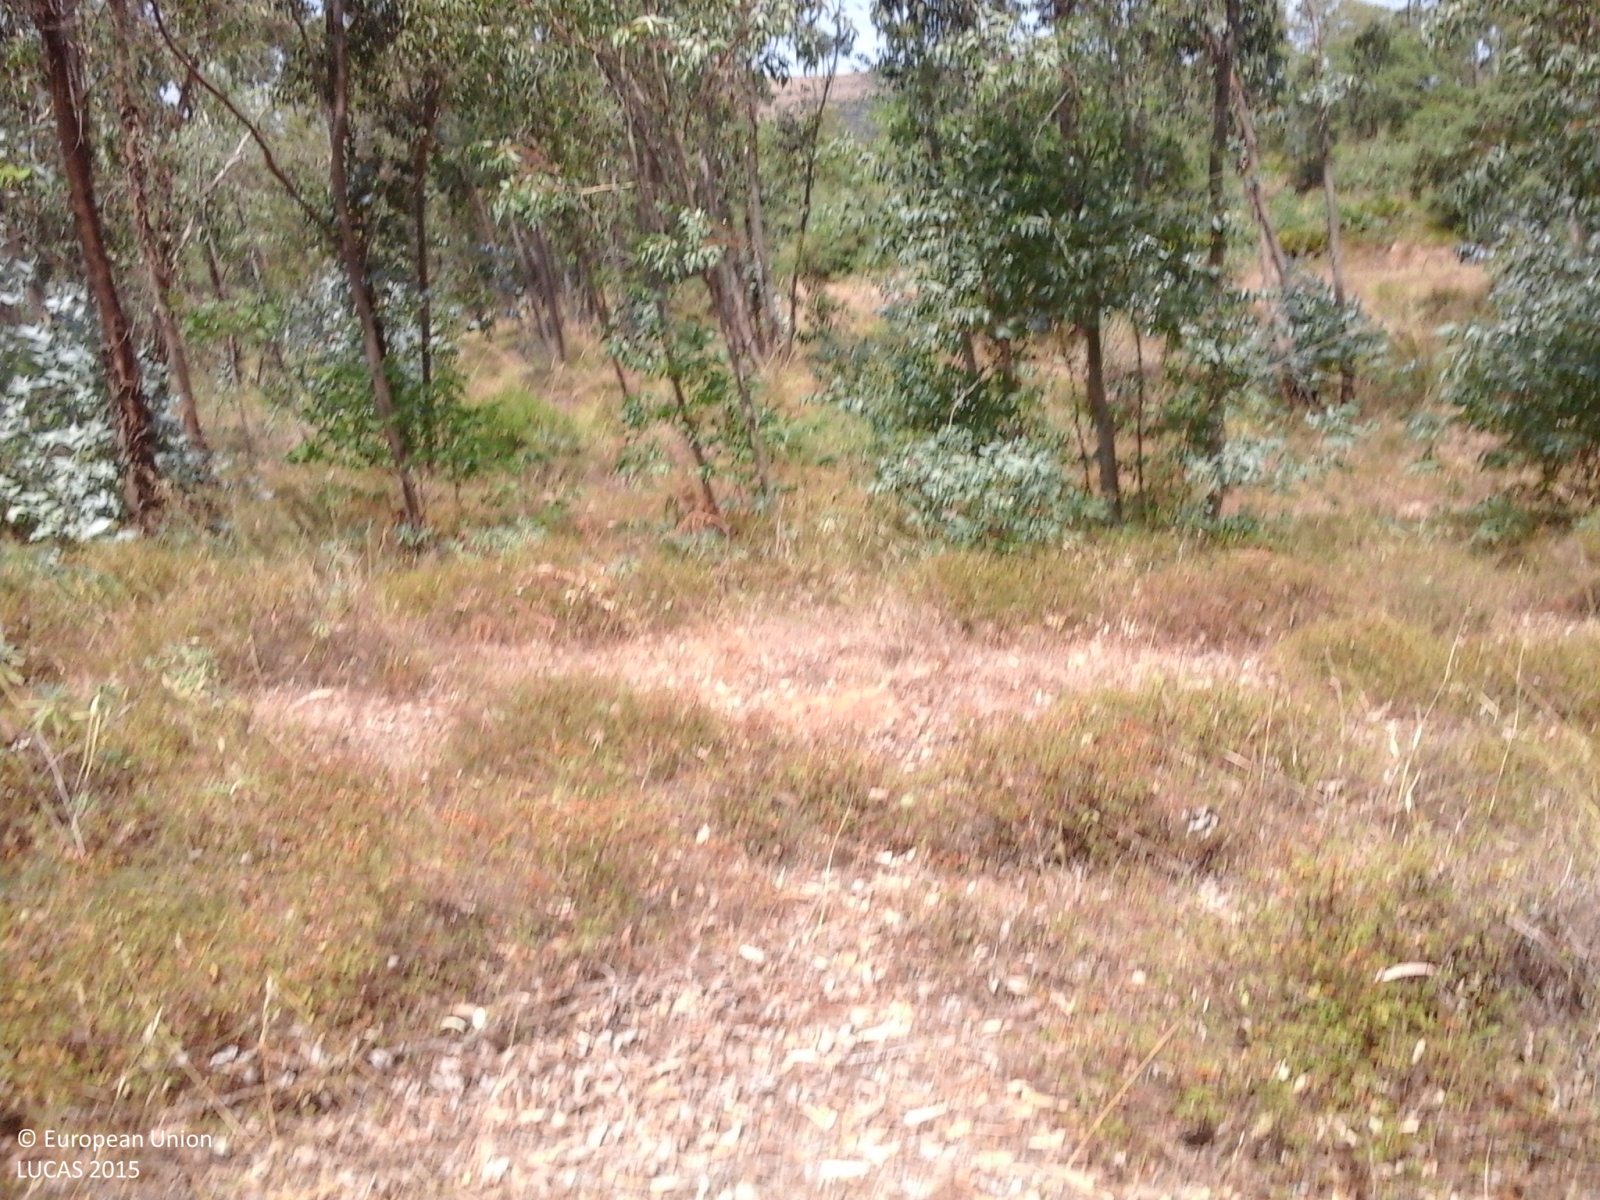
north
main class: Woodland
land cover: Broadleaved woodland
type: broadleaved evergreen forest
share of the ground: > 75 %
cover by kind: broadleaved forest trees 100 %
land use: Forestry
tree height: > 5 m
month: July
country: IT
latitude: 37.2660
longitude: 14.3532
